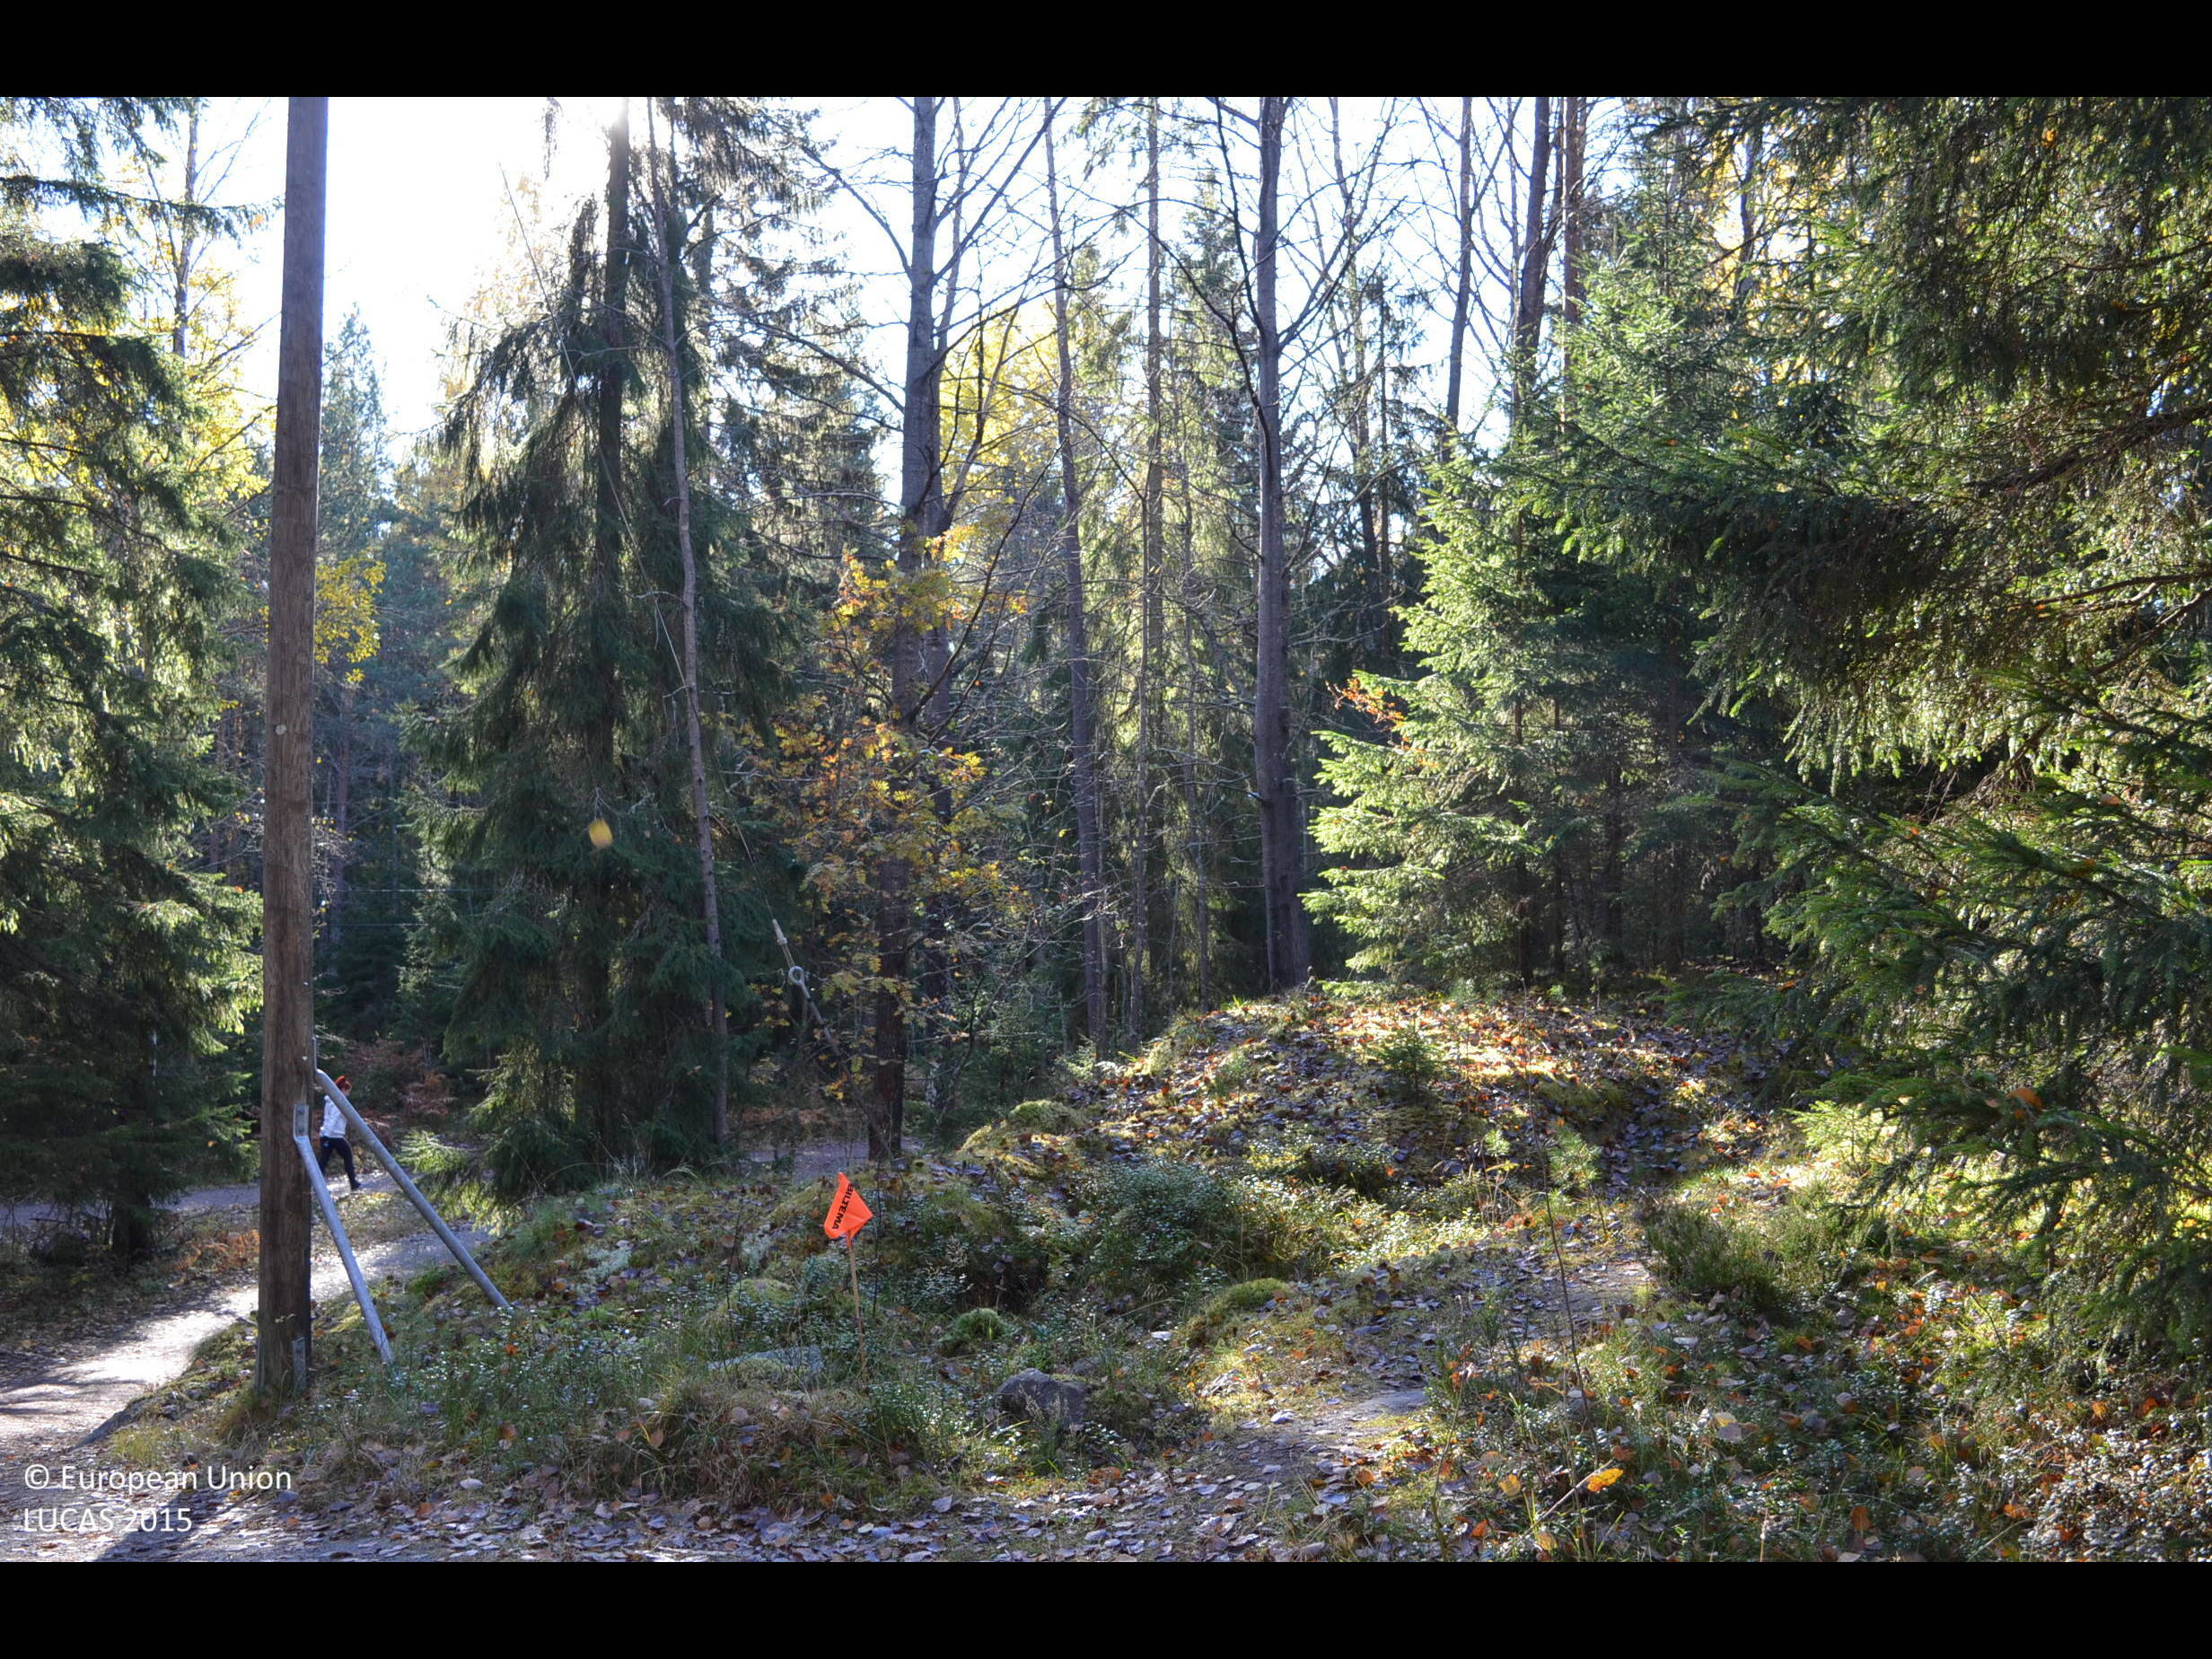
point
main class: Woodland
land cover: Other mixed woodland
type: boreal forest
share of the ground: 50 - 75 %
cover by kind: coniferous forest trees 40 %, broadleaved forest trees 30 %, shrubs 15 %, lichens and mosses 10 %
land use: Amenities, museums, leisure
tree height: > 5 m
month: October
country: FI
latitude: 61.5118
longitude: 23.8234
